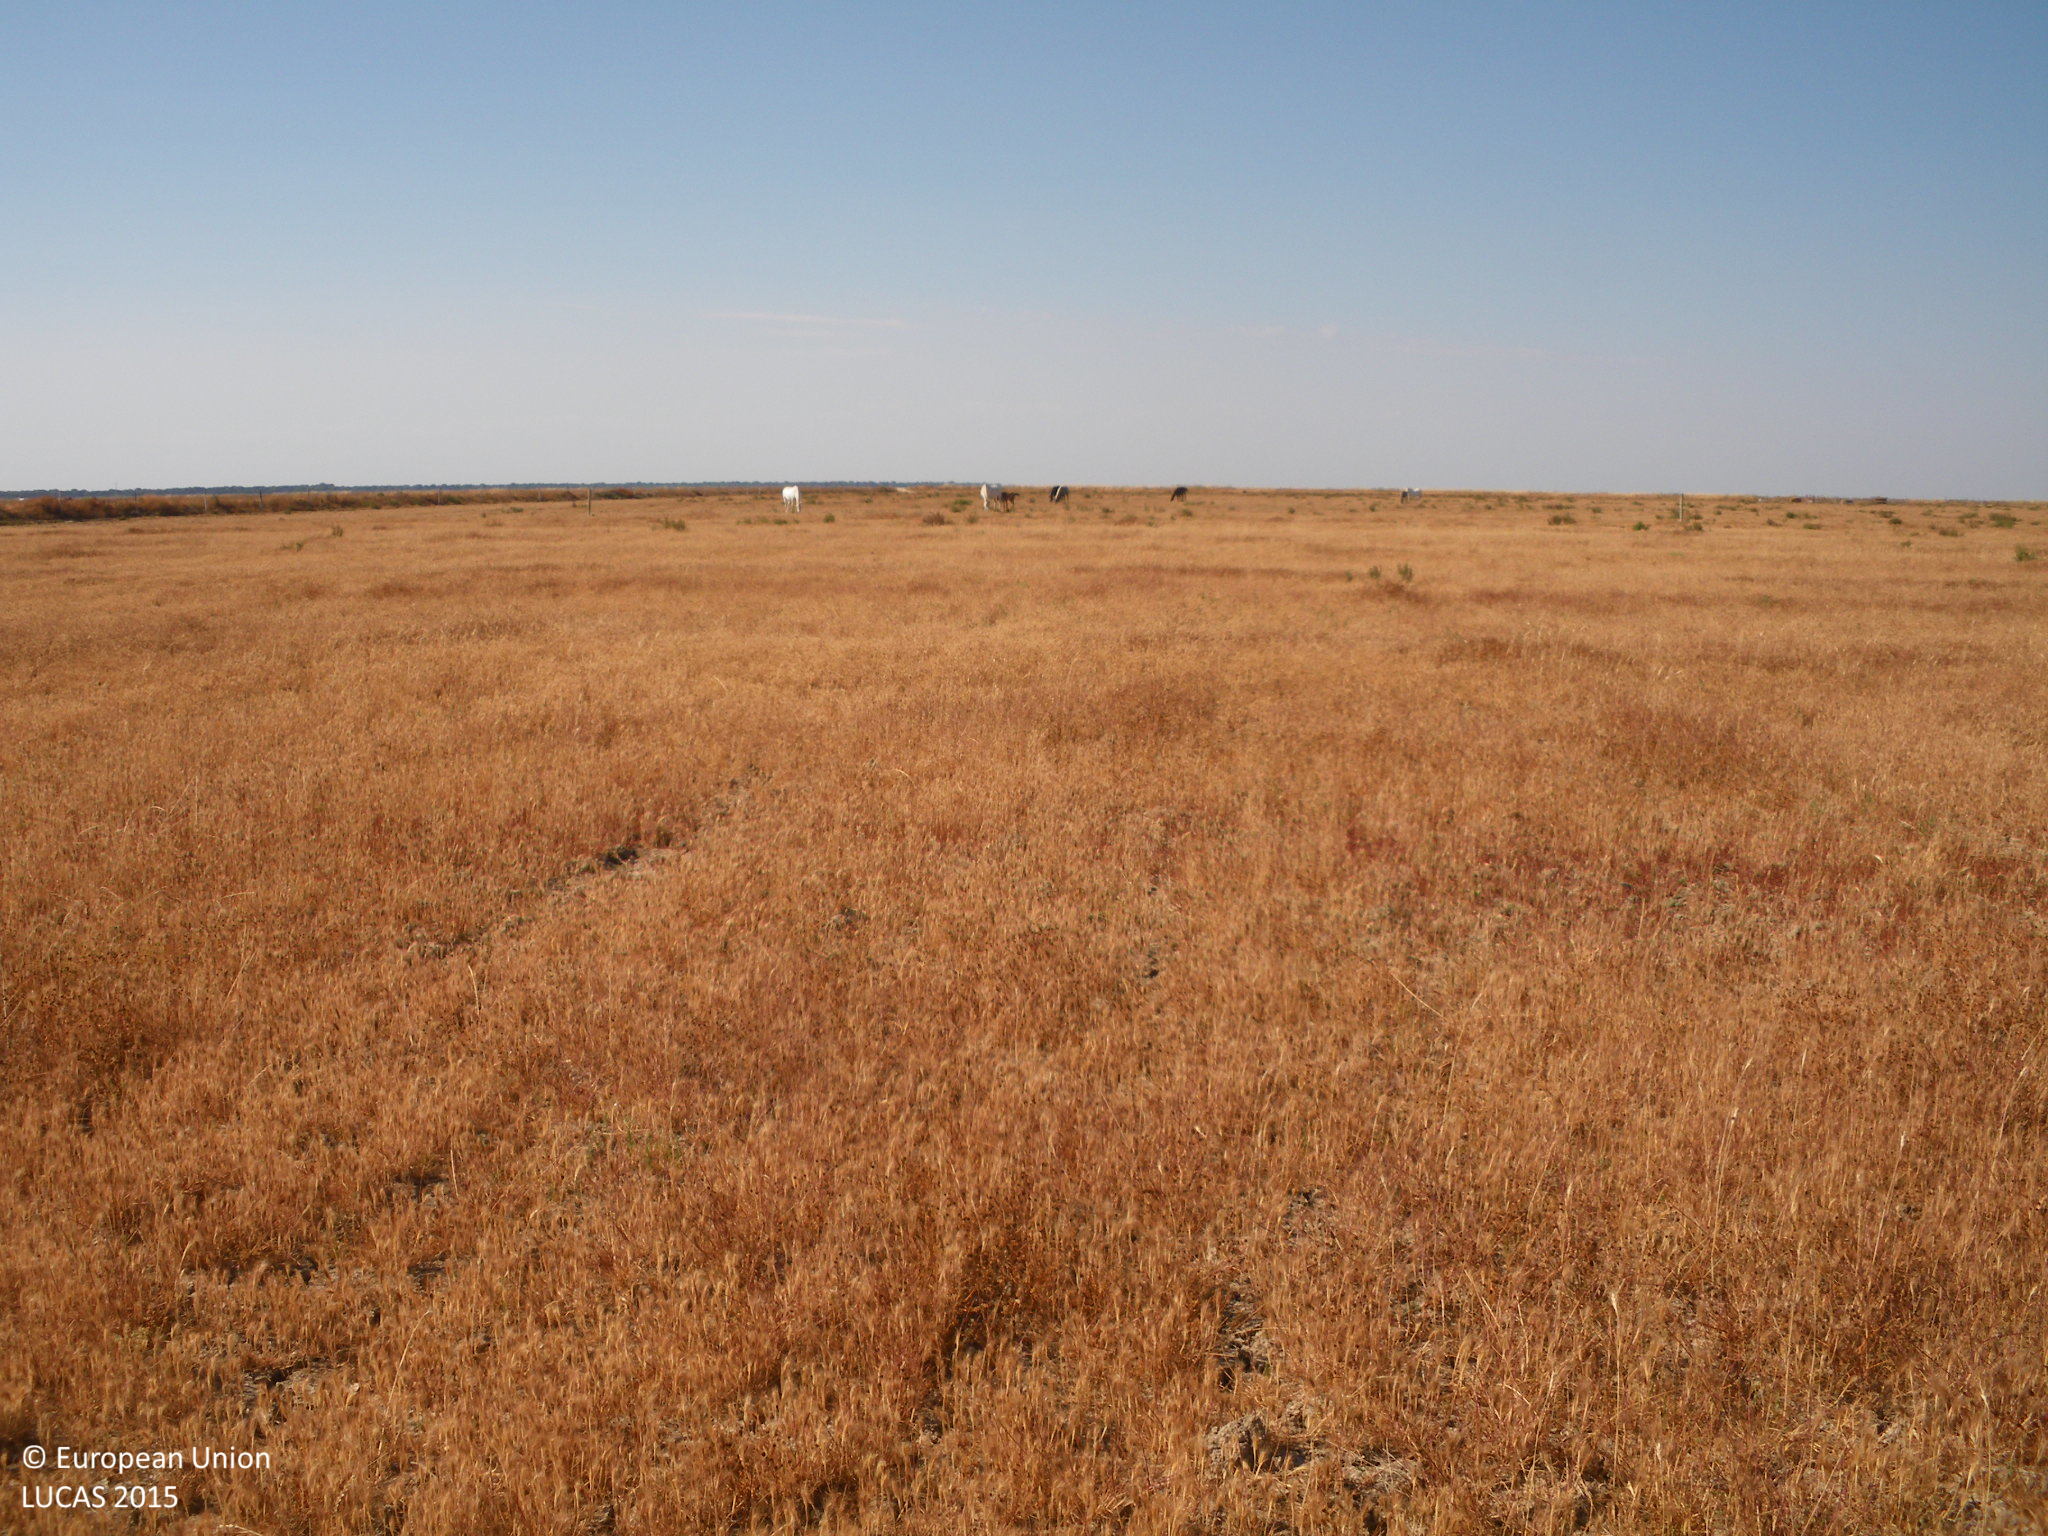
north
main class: Grassland
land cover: Spontaneously vegetated surfaces
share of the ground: > 75 %
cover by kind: herbaceous plants 100 %
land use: Agriculture (excluding fallow land and kitchen gardens)
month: May
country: ES
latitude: 36.8138
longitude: -6.2825
